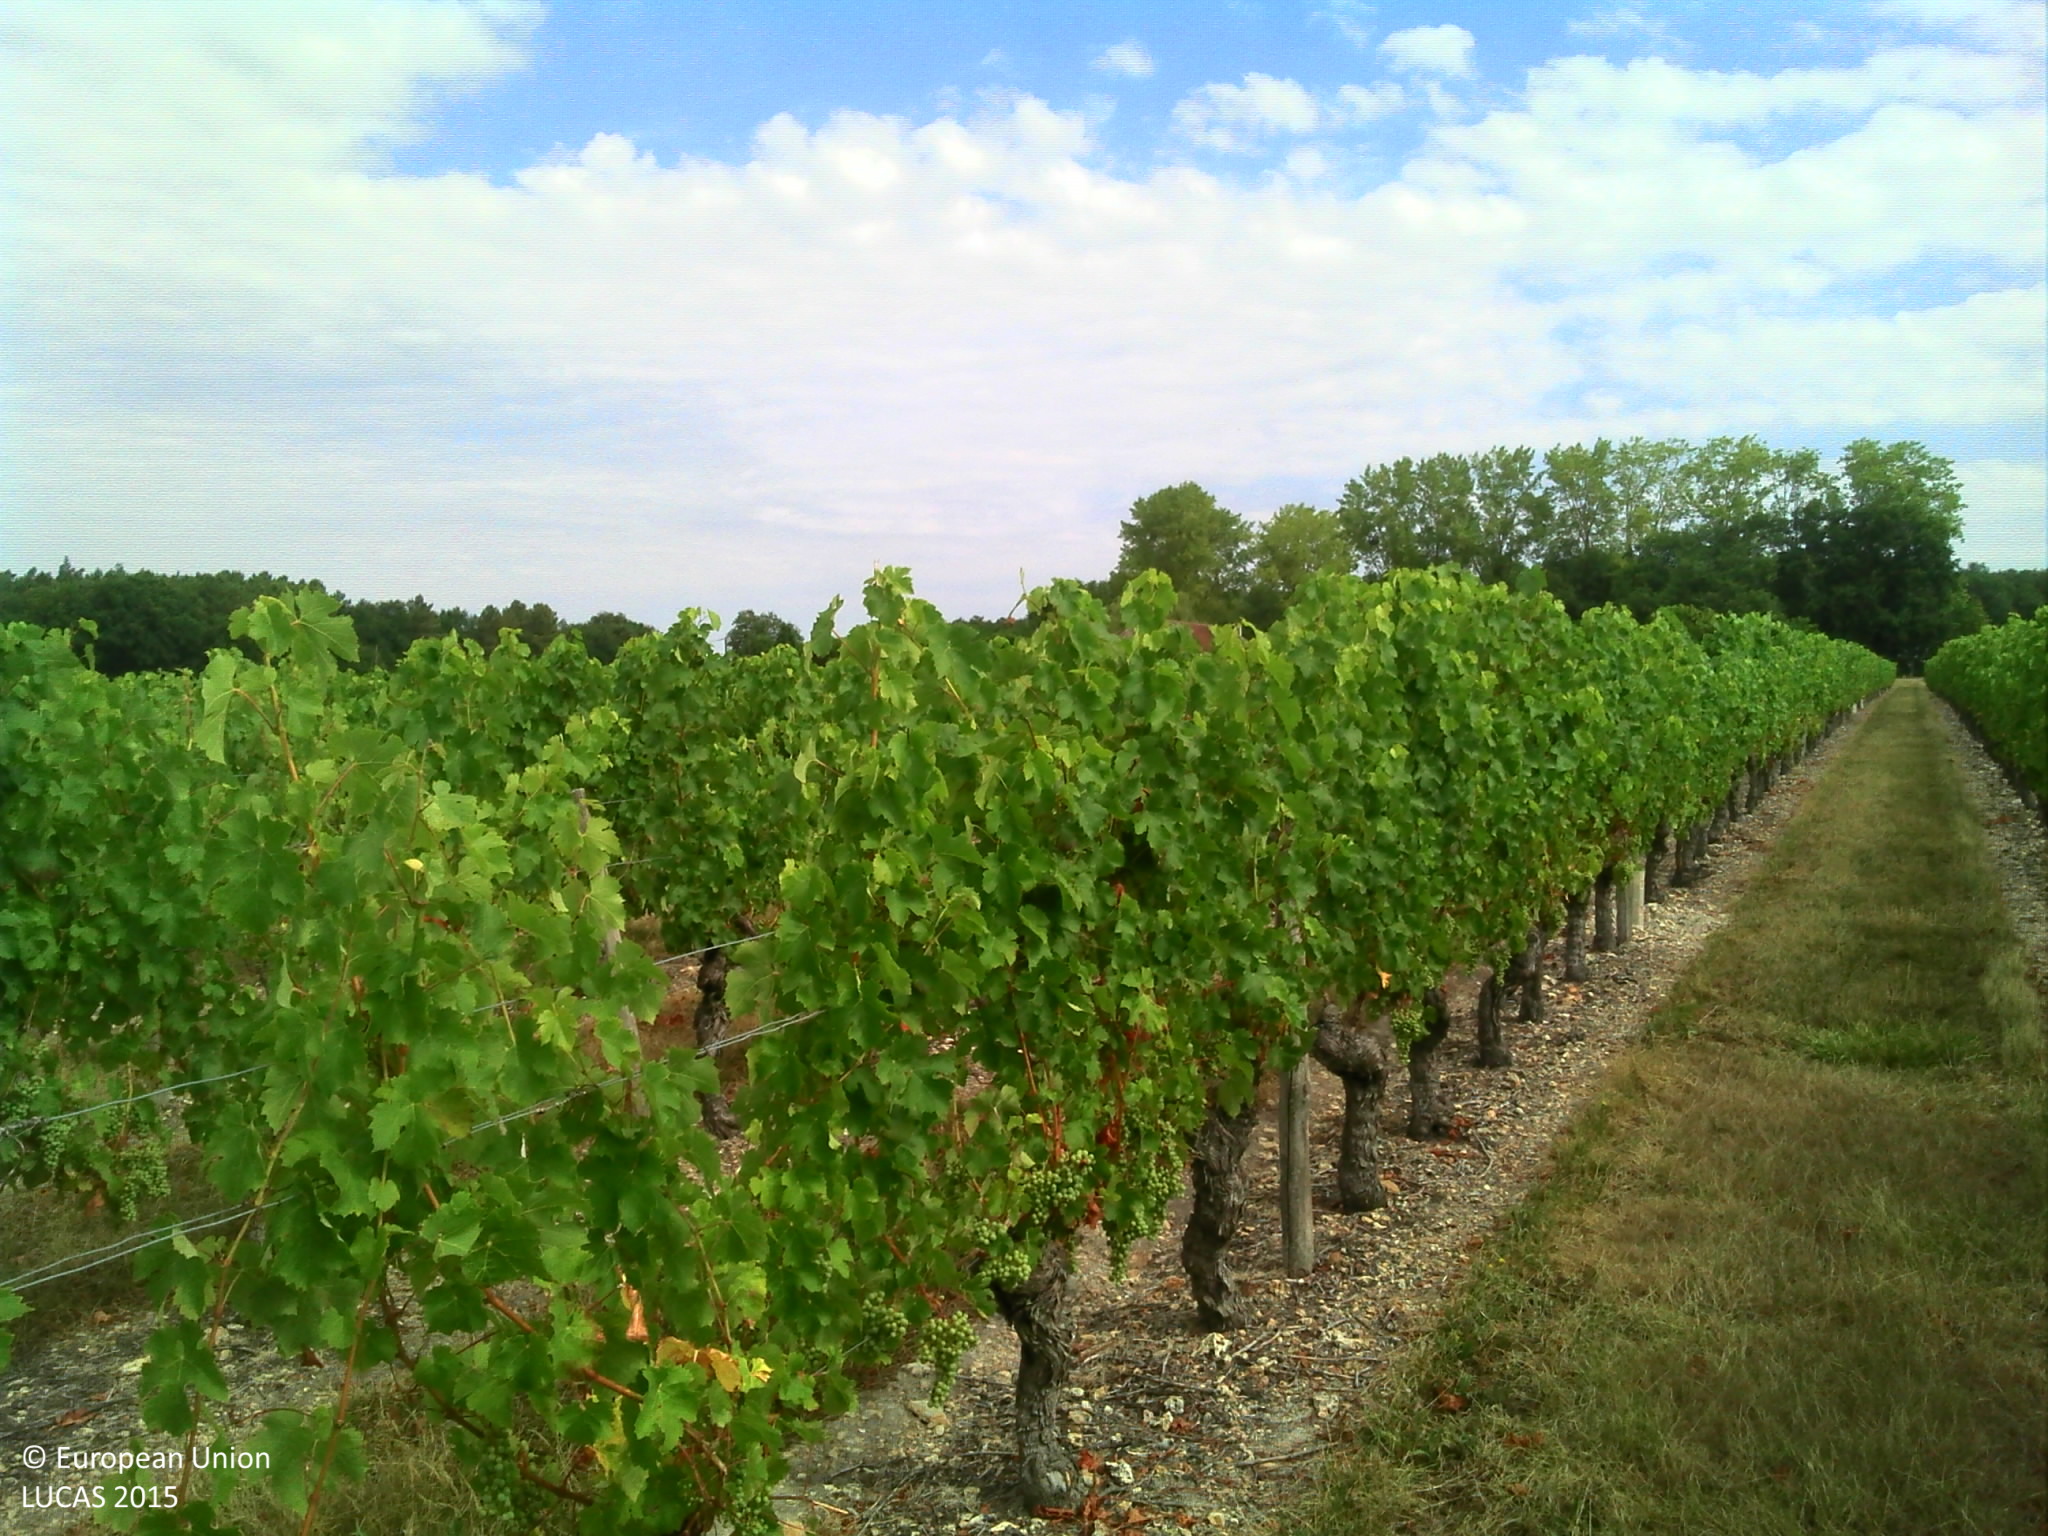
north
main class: Cropland
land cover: Vineyards
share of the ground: 50 - 75 %
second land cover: Grassland without tree/shrub cover
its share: 50 - 75 %
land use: Agriculture (excluding fallow land and kitchen gardens)
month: August
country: FR
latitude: 47.1660
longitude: 0.3617
